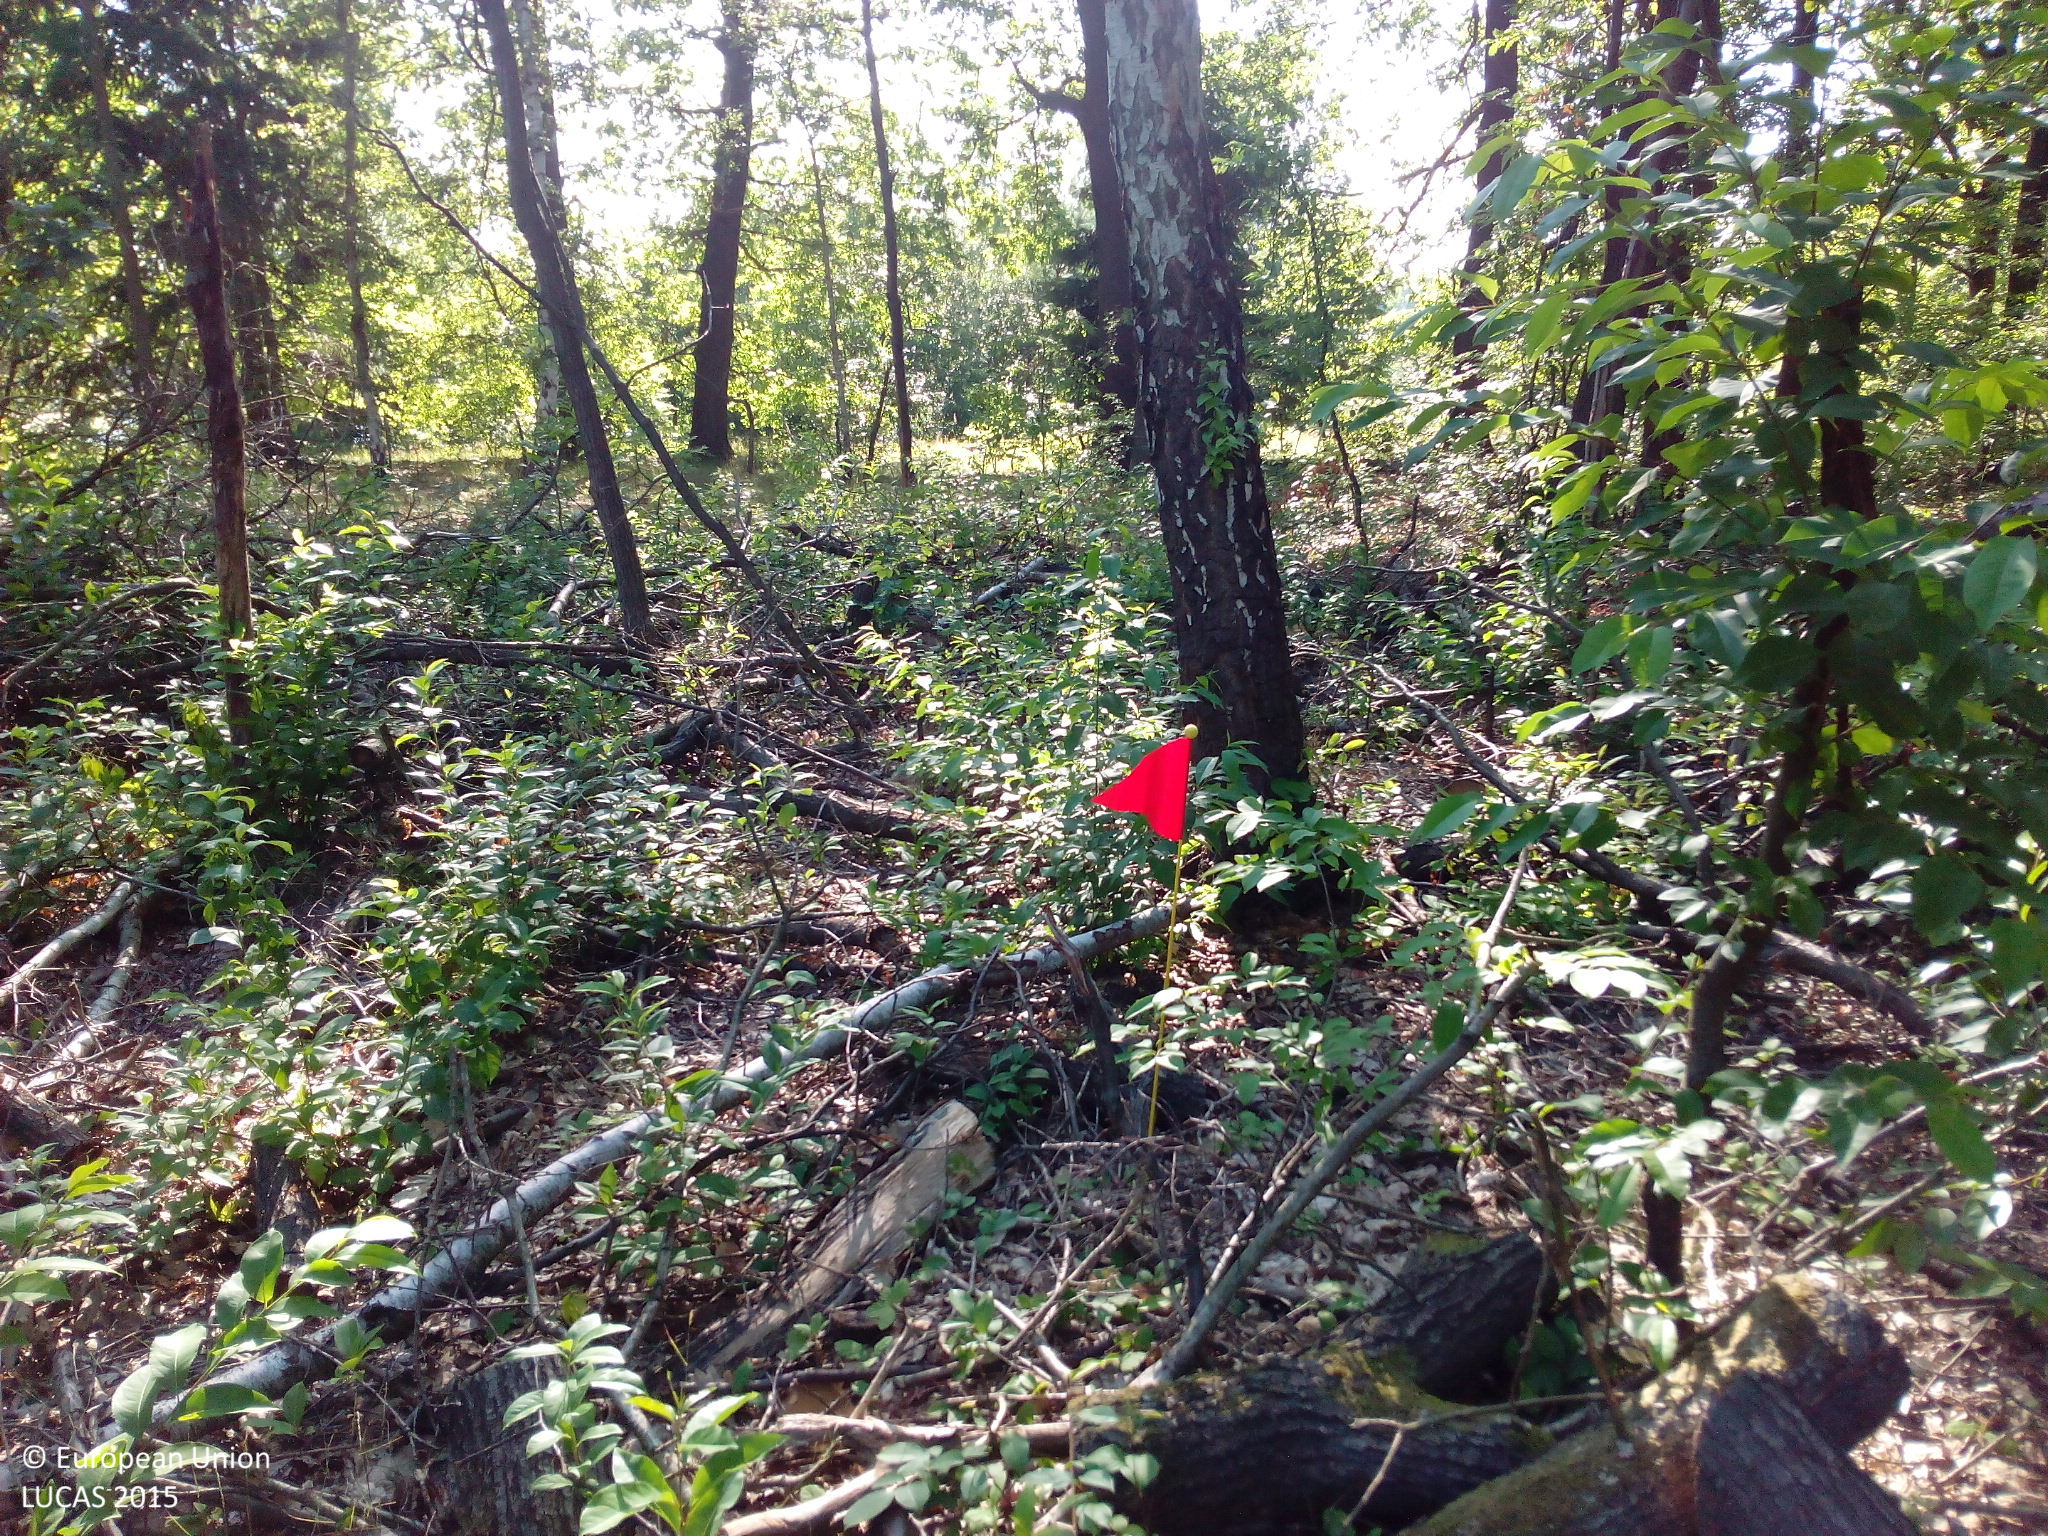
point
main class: Woodland
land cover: Broadleaved woodland
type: mesophytic deciduous forest
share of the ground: 50 - 75 %
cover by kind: broadleaved forest trees 50 %, unconsolidated bare surface 50 %
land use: Forestry
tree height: > 5 m
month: July
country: DE
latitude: 52.4277
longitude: 13.0736
